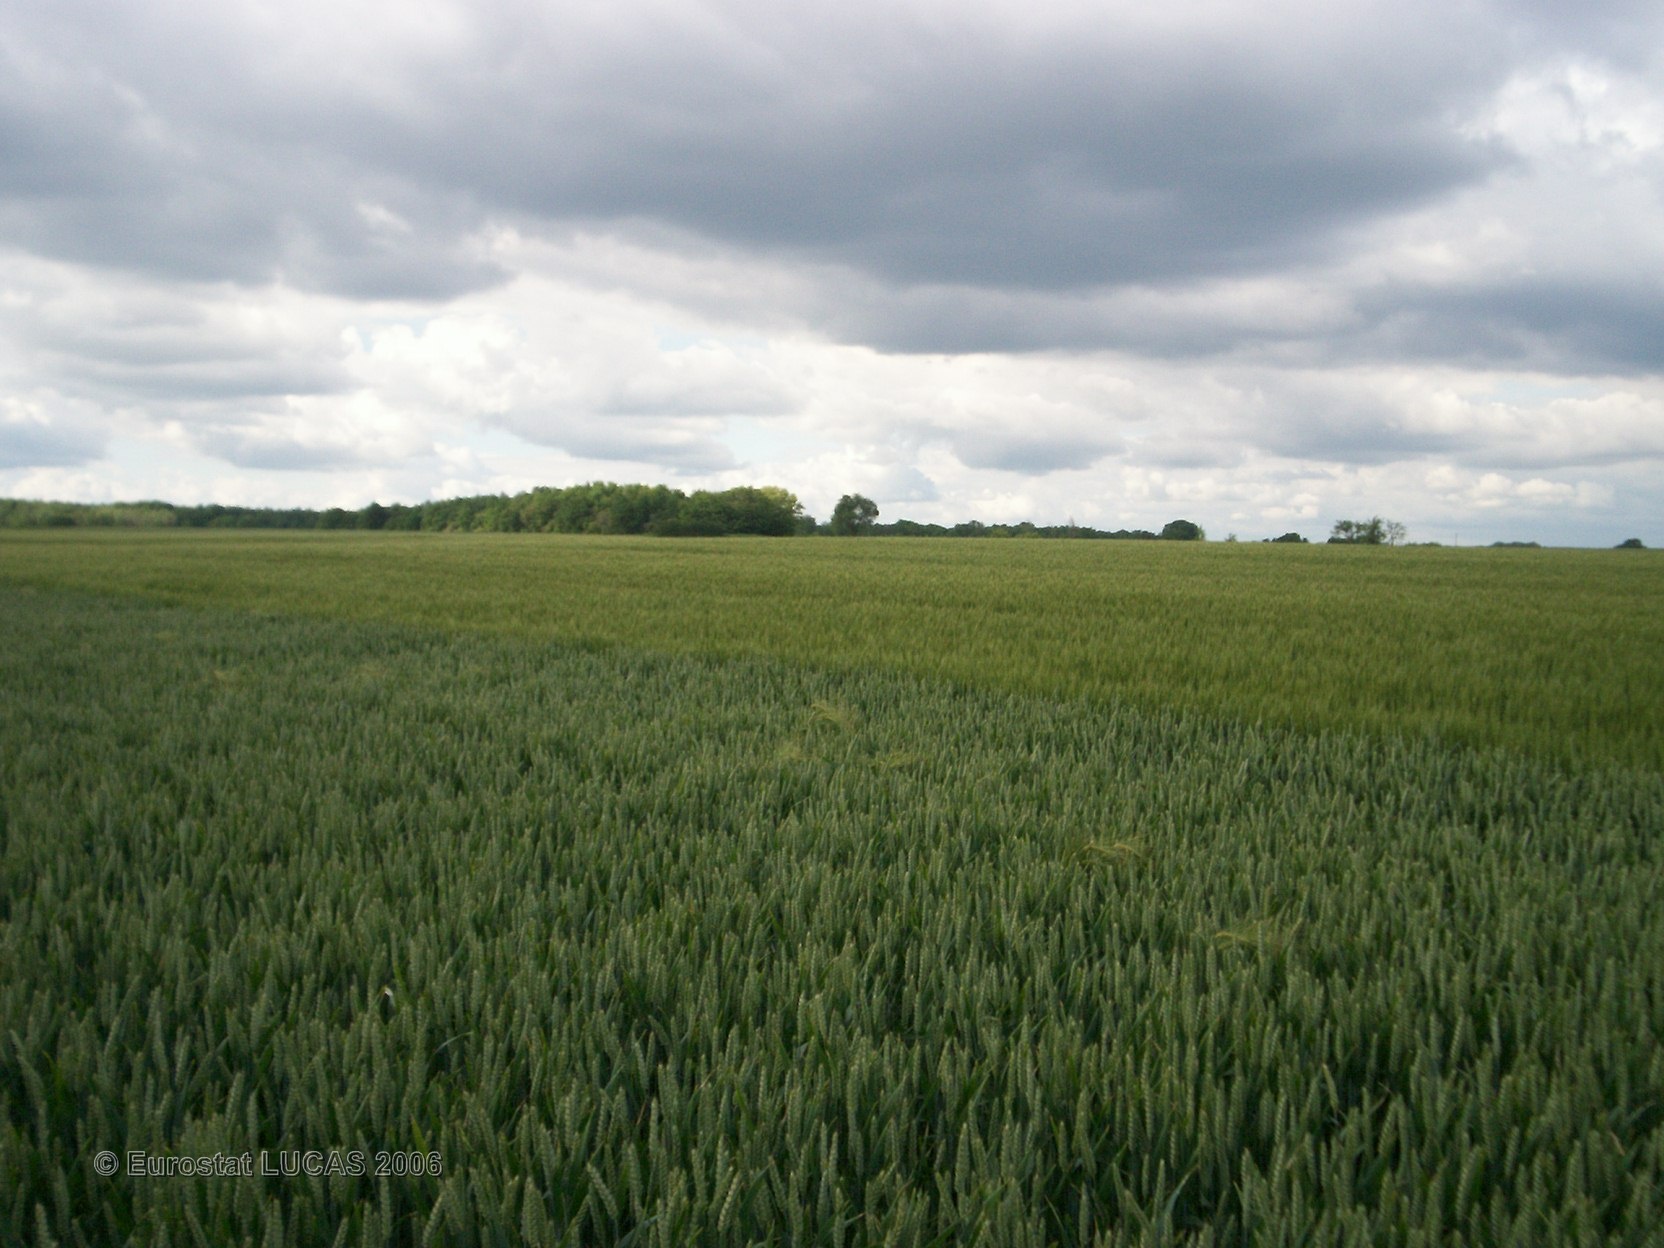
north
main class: Cropland
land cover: Common wheat
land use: Agriculture (excluding fallow land and kitchen gardens)
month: May
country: FR
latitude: 46.9926
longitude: 1.5331
